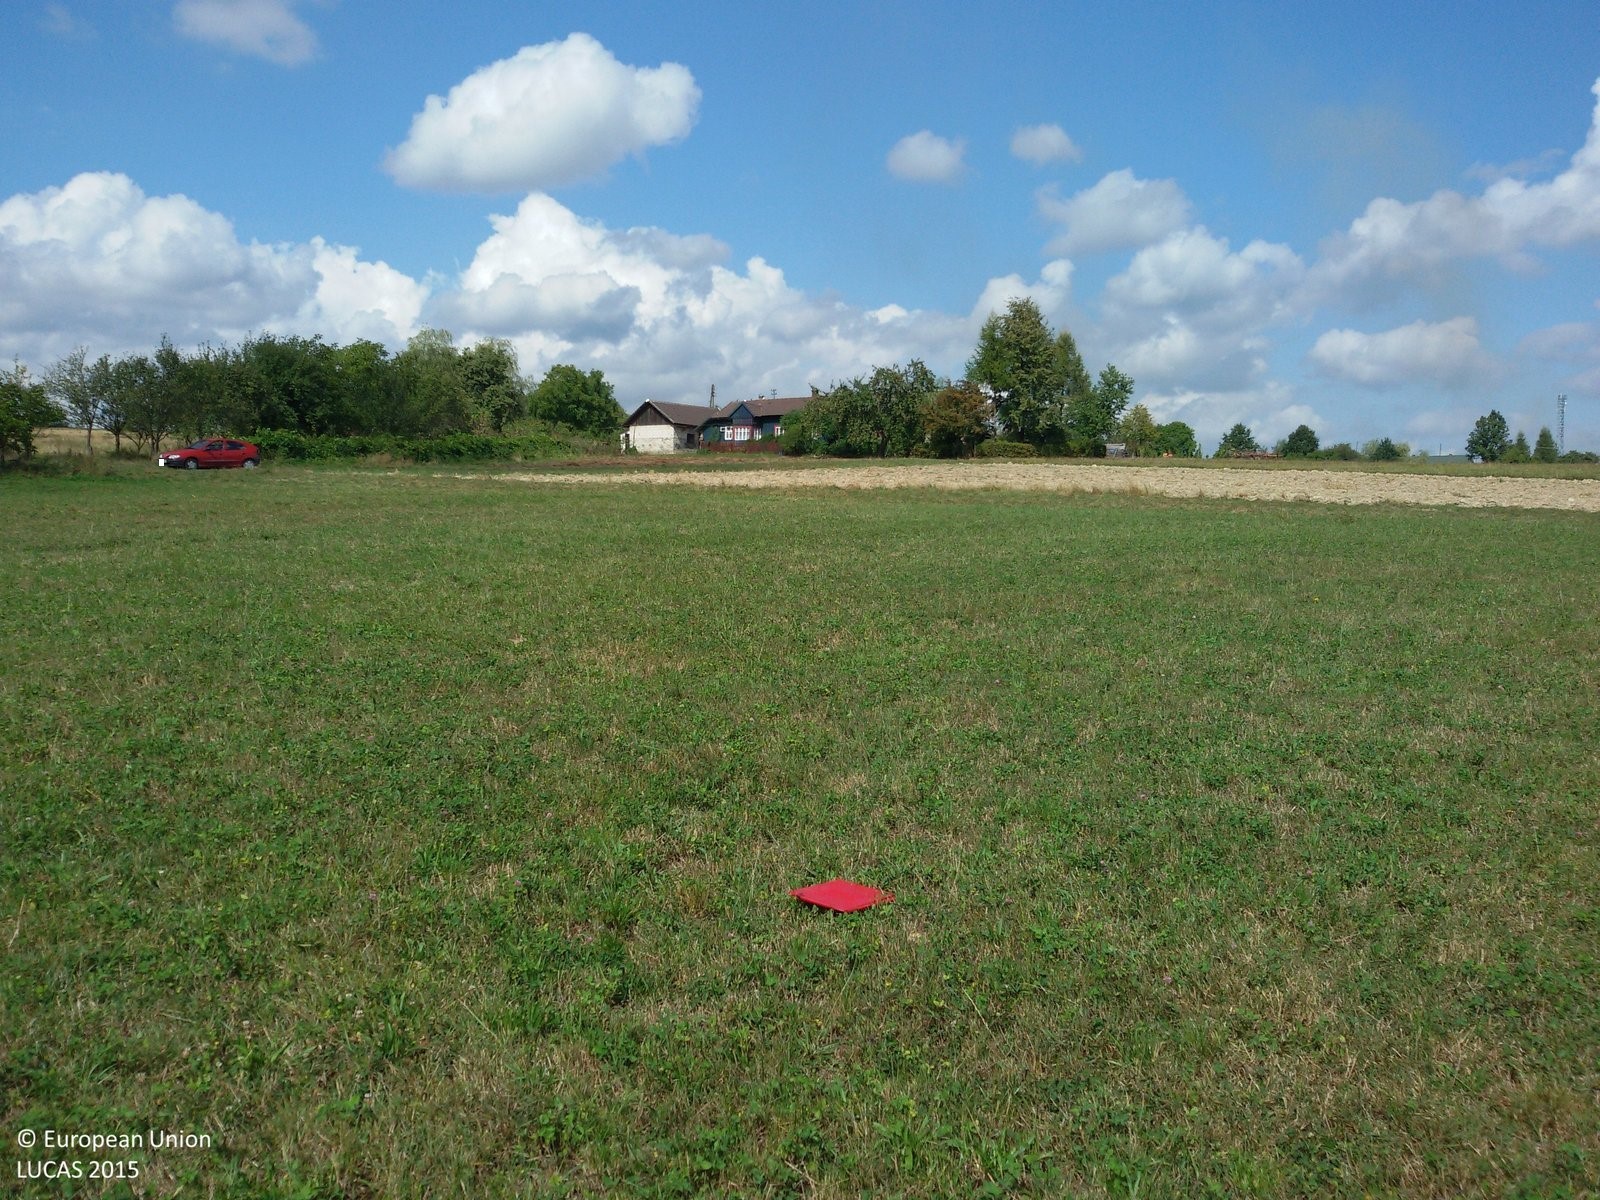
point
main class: Grassland
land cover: Grassland without tree/shrub cover
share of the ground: > 75 %
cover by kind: herbaceous plants 100 %
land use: Agriculture (excluding fallow land and kitchen gardens)
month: September
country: PL
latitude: 49.7911
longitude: 21.2283
